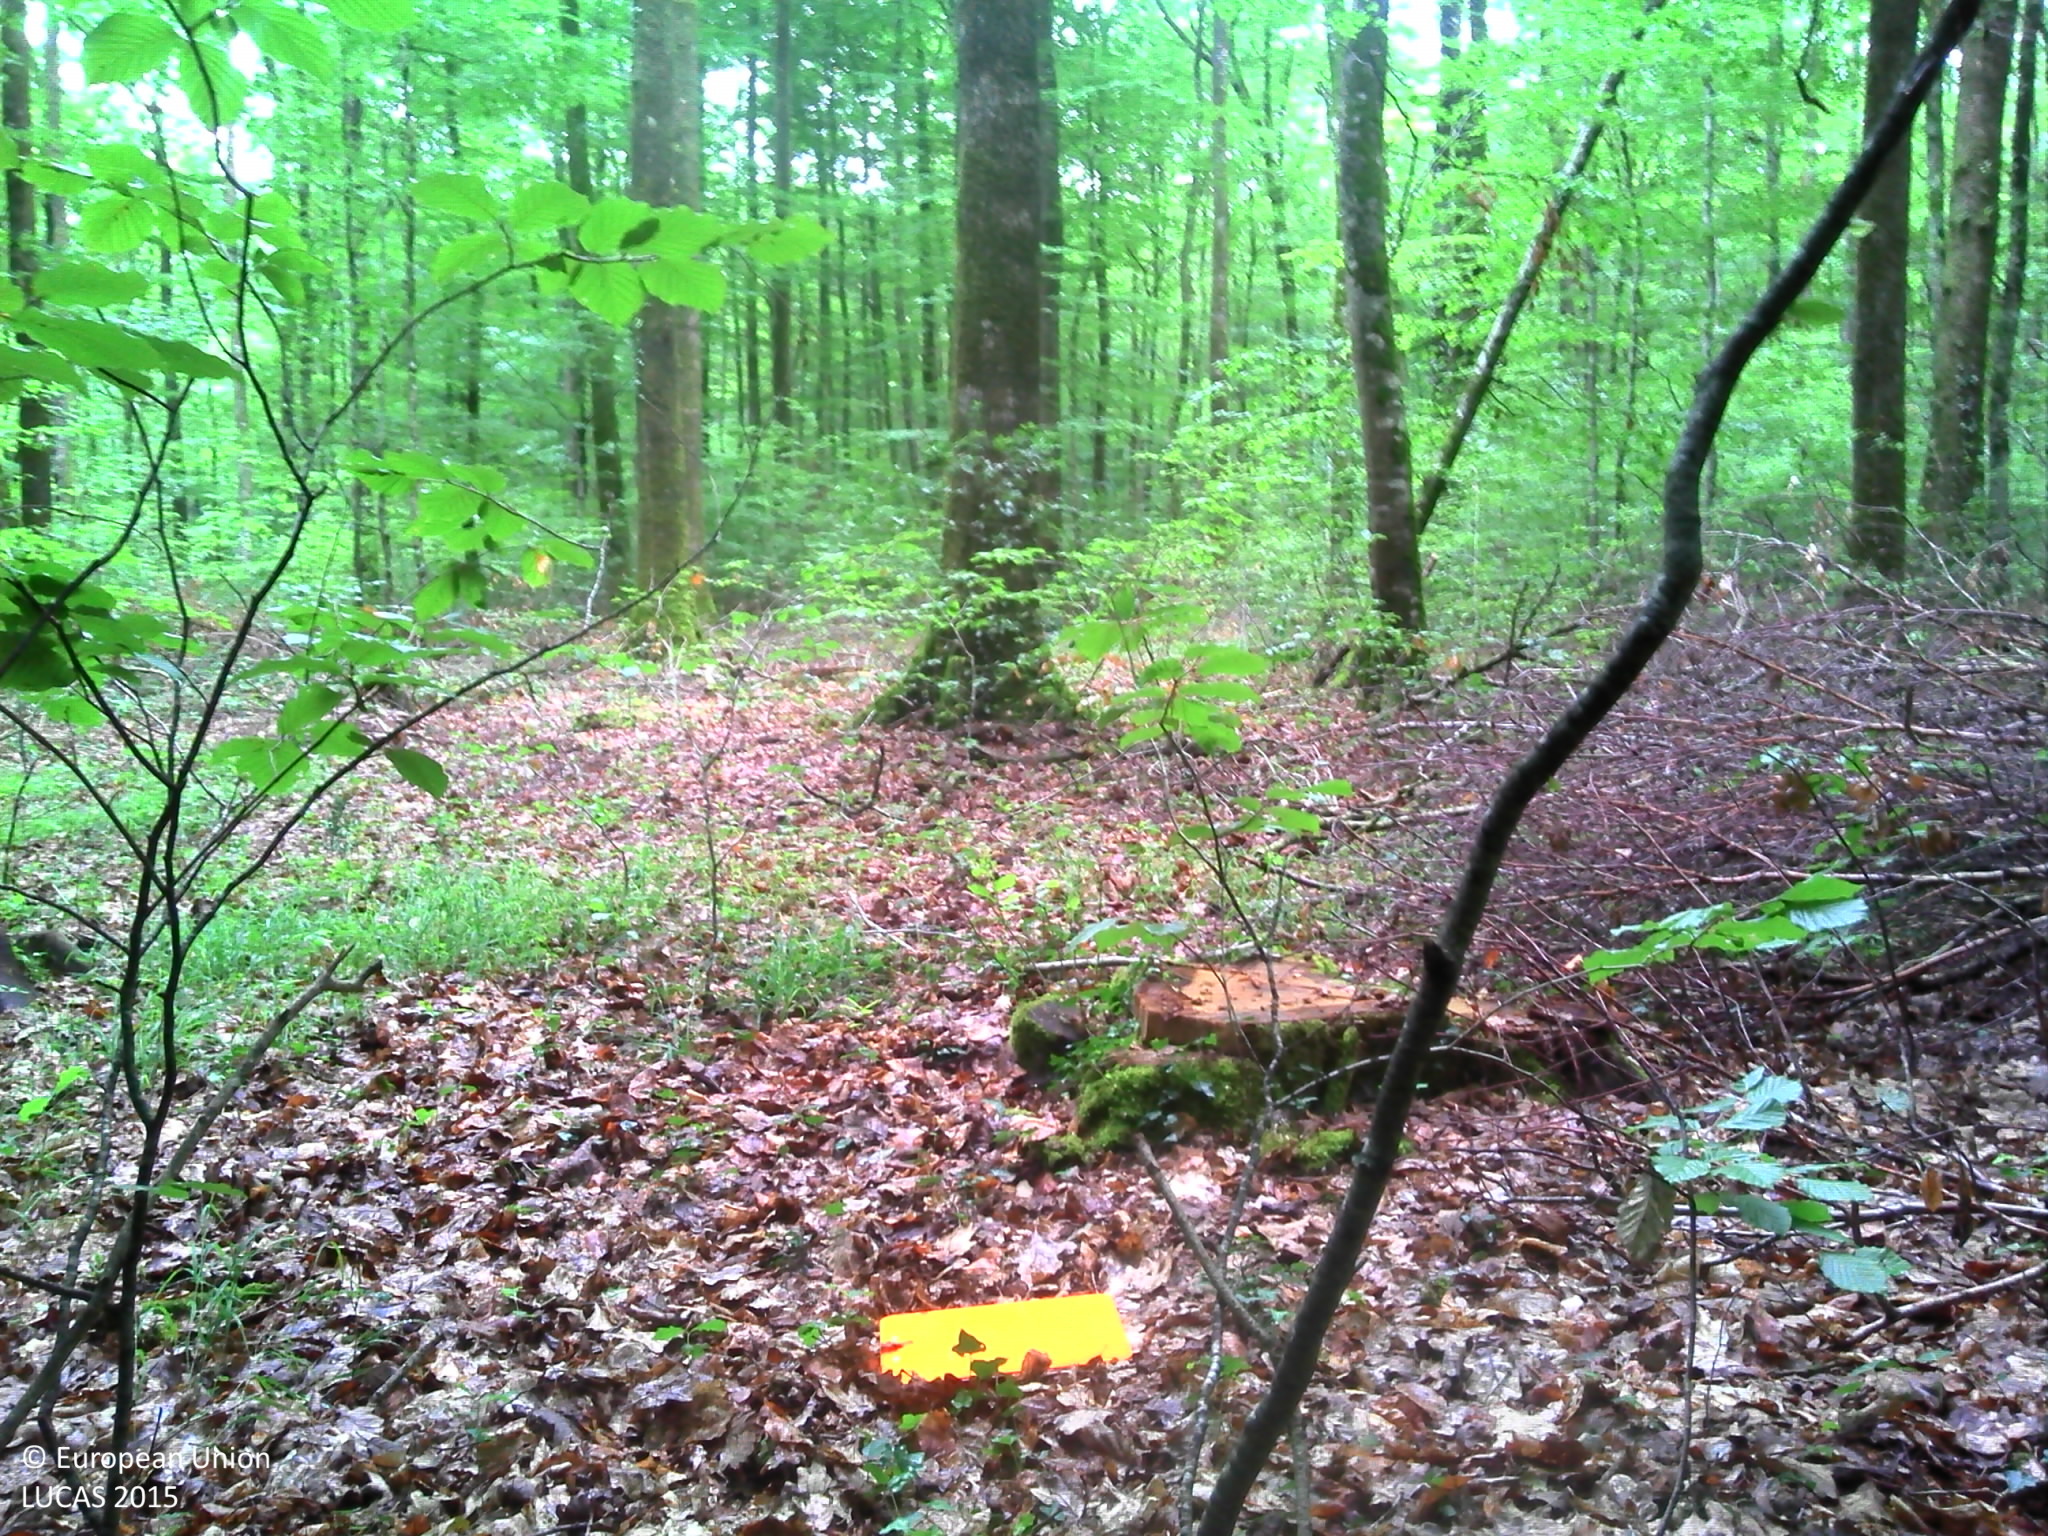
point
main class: Woodland
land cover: Broadleaved woodland
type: beech forest
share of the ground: > 75 %
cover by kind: broadleaved forest trees 95 %, herbaceous plants 5 %
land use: Forestry
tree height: > 5 m
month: July
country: FR
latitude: 47.5530
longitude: -1.7806
